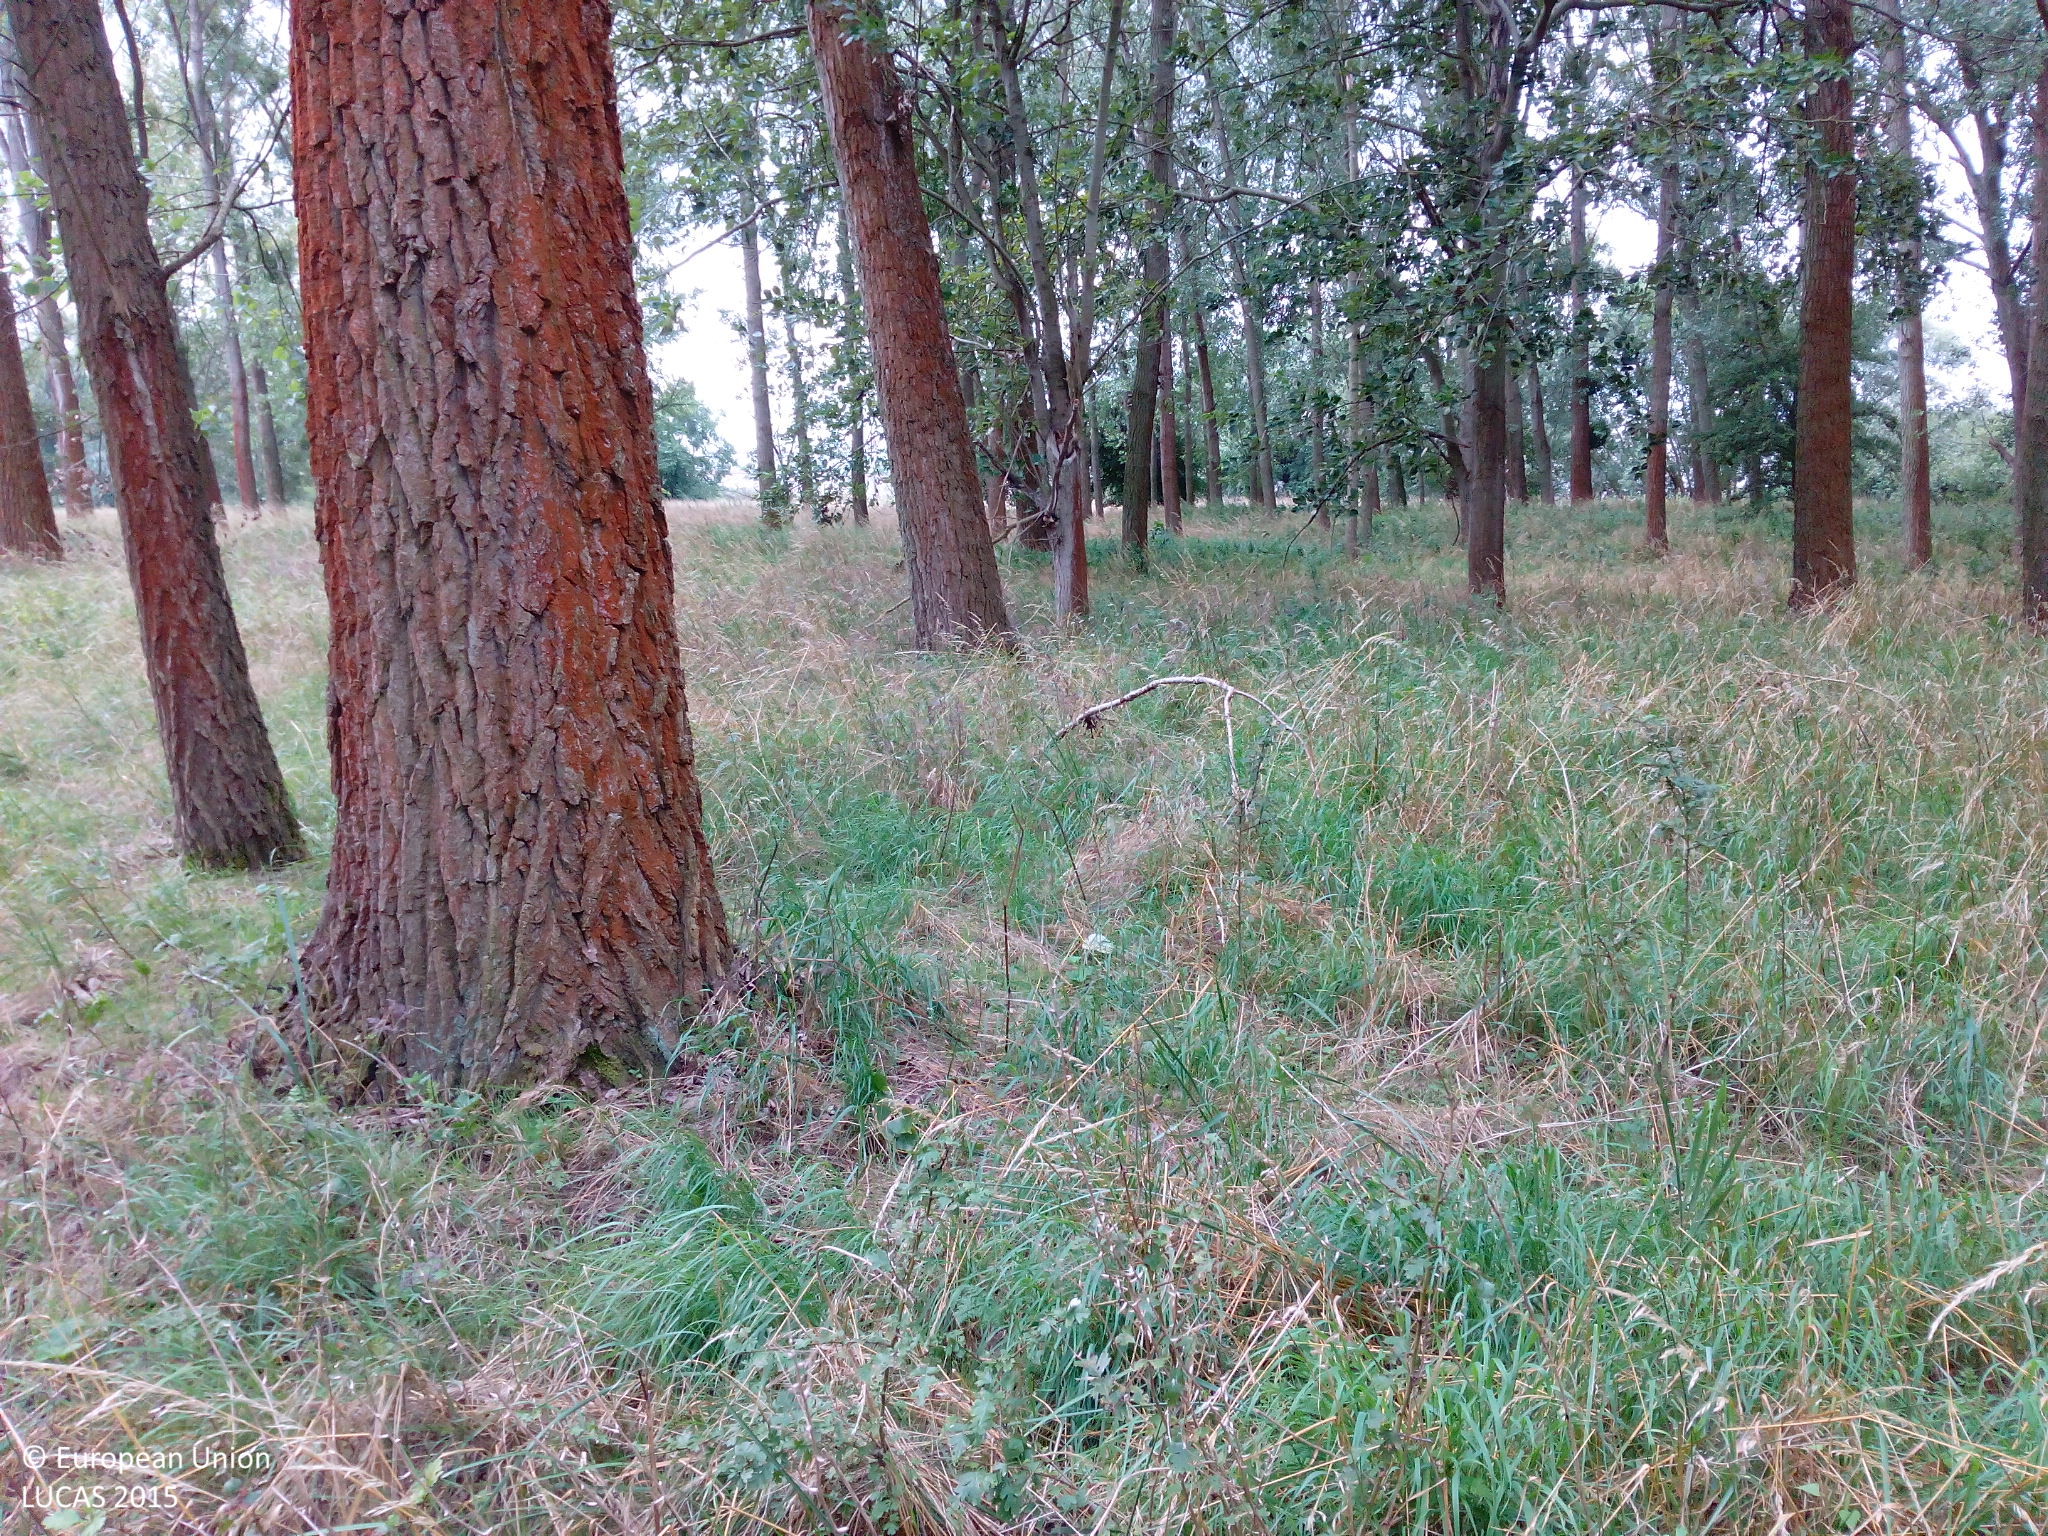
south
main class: Woodland
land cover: Broadleaved woodland
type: mesophytic deciduous forest
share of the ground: > 75 %
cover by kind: broadleaved forest trees 75 %, herbaceous plants 25 %
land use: Forestry
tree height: > 5 m
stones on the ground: < 10 %
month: July
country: DE
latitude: 52.7375
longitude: 14.1331
